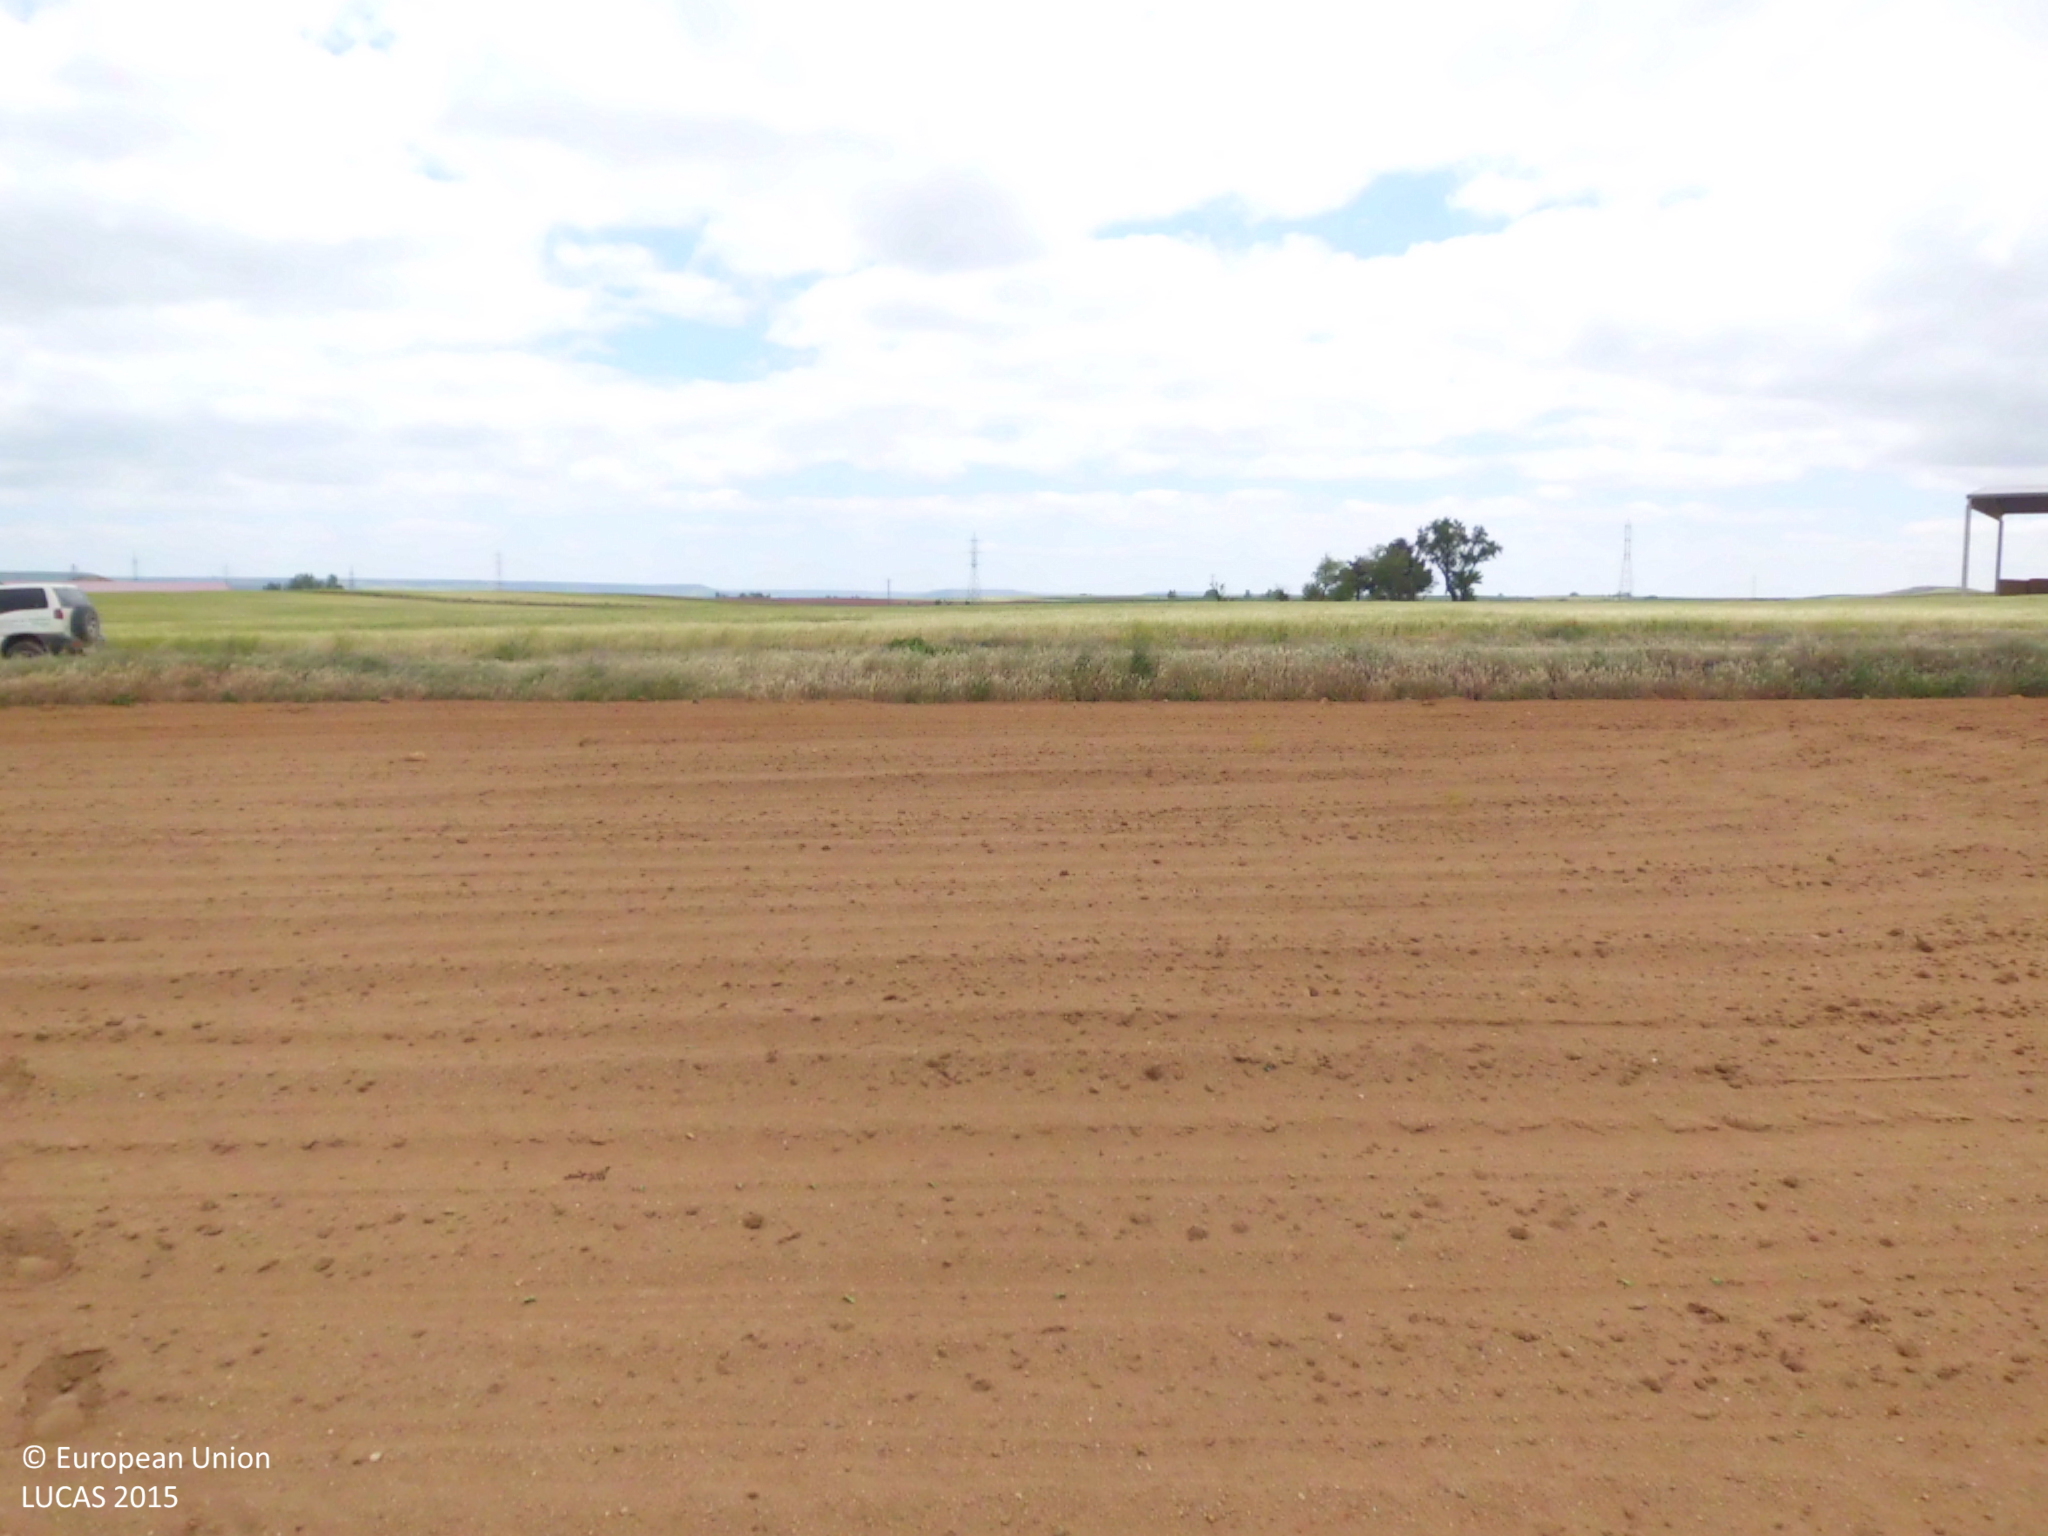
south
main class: Cropland
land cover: Sunflower
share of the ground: < 10 %
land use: Agriculture (excluding fallow land and kitchen gardens)
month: May
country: ES
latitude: 42.5141
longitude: -4.0280
